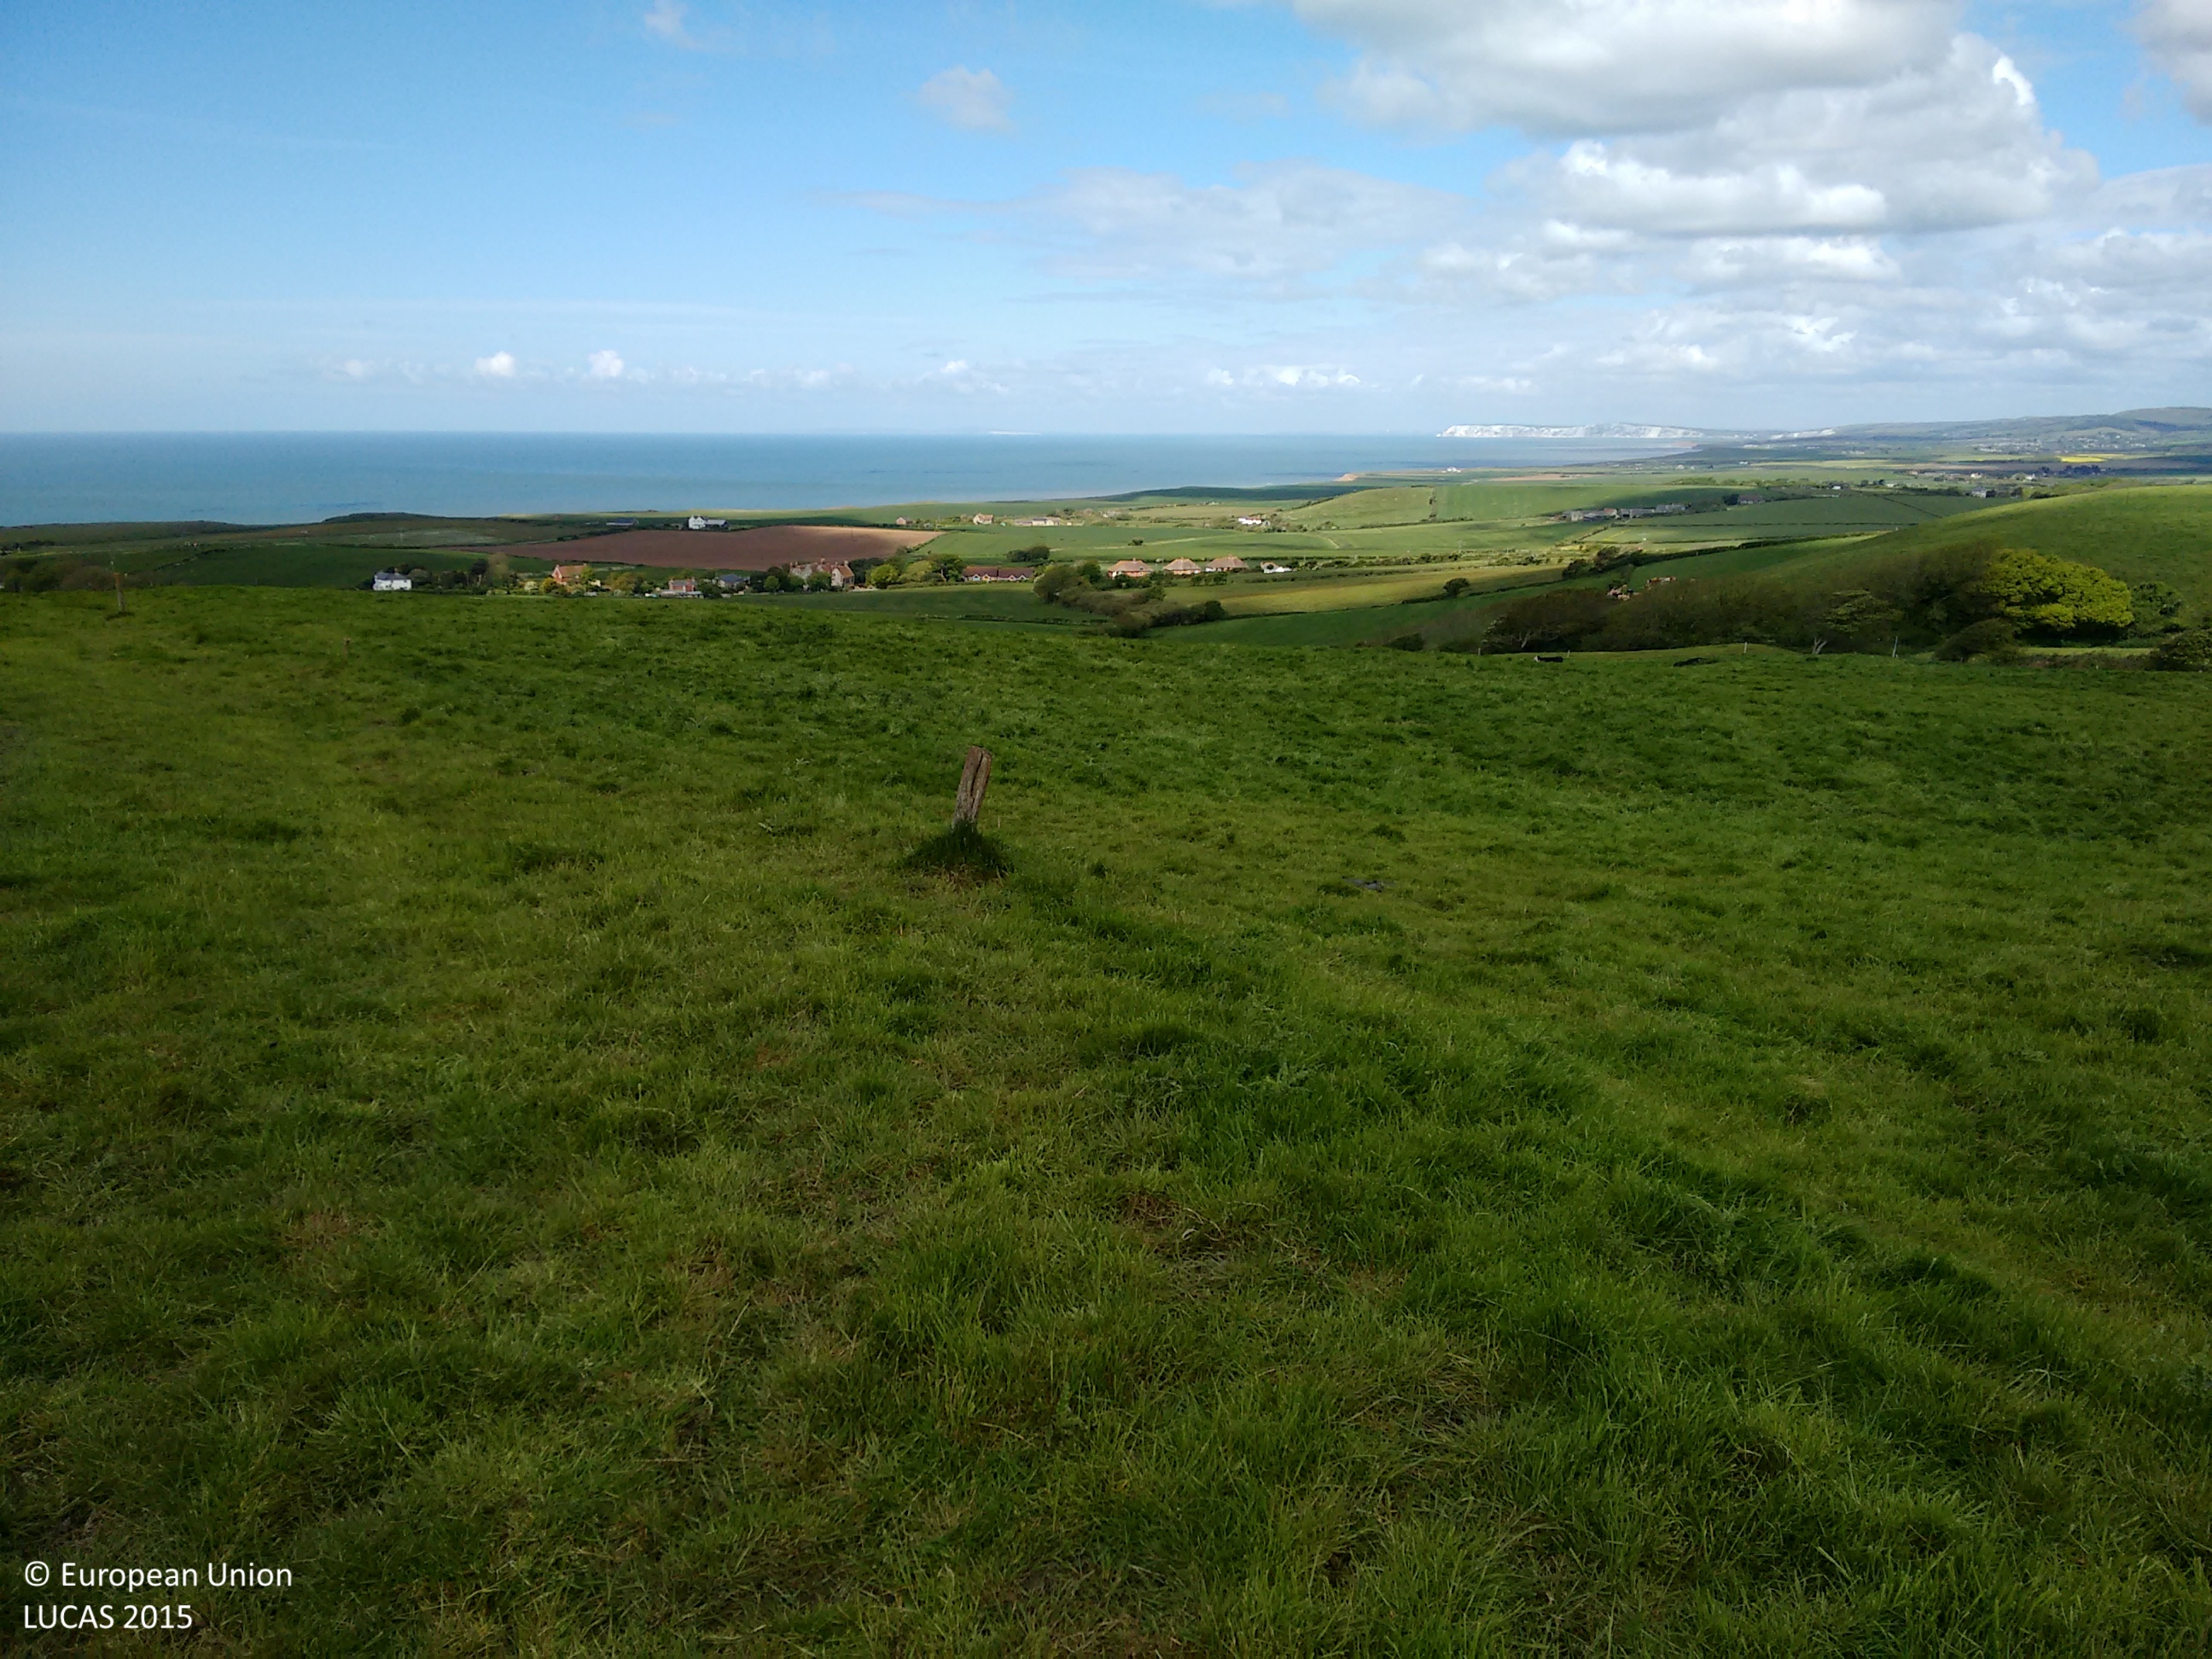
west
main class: Grassland
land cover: Grassland without tree/shrub cover
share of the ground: > 75 %
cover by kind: herbaceous plants 90 %, unconsolidated bare surface 10 %
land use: Agriculture (excluding fallow land and kitchen gardens)
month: May
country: GB
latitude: 50.6003
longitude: -1.3084
